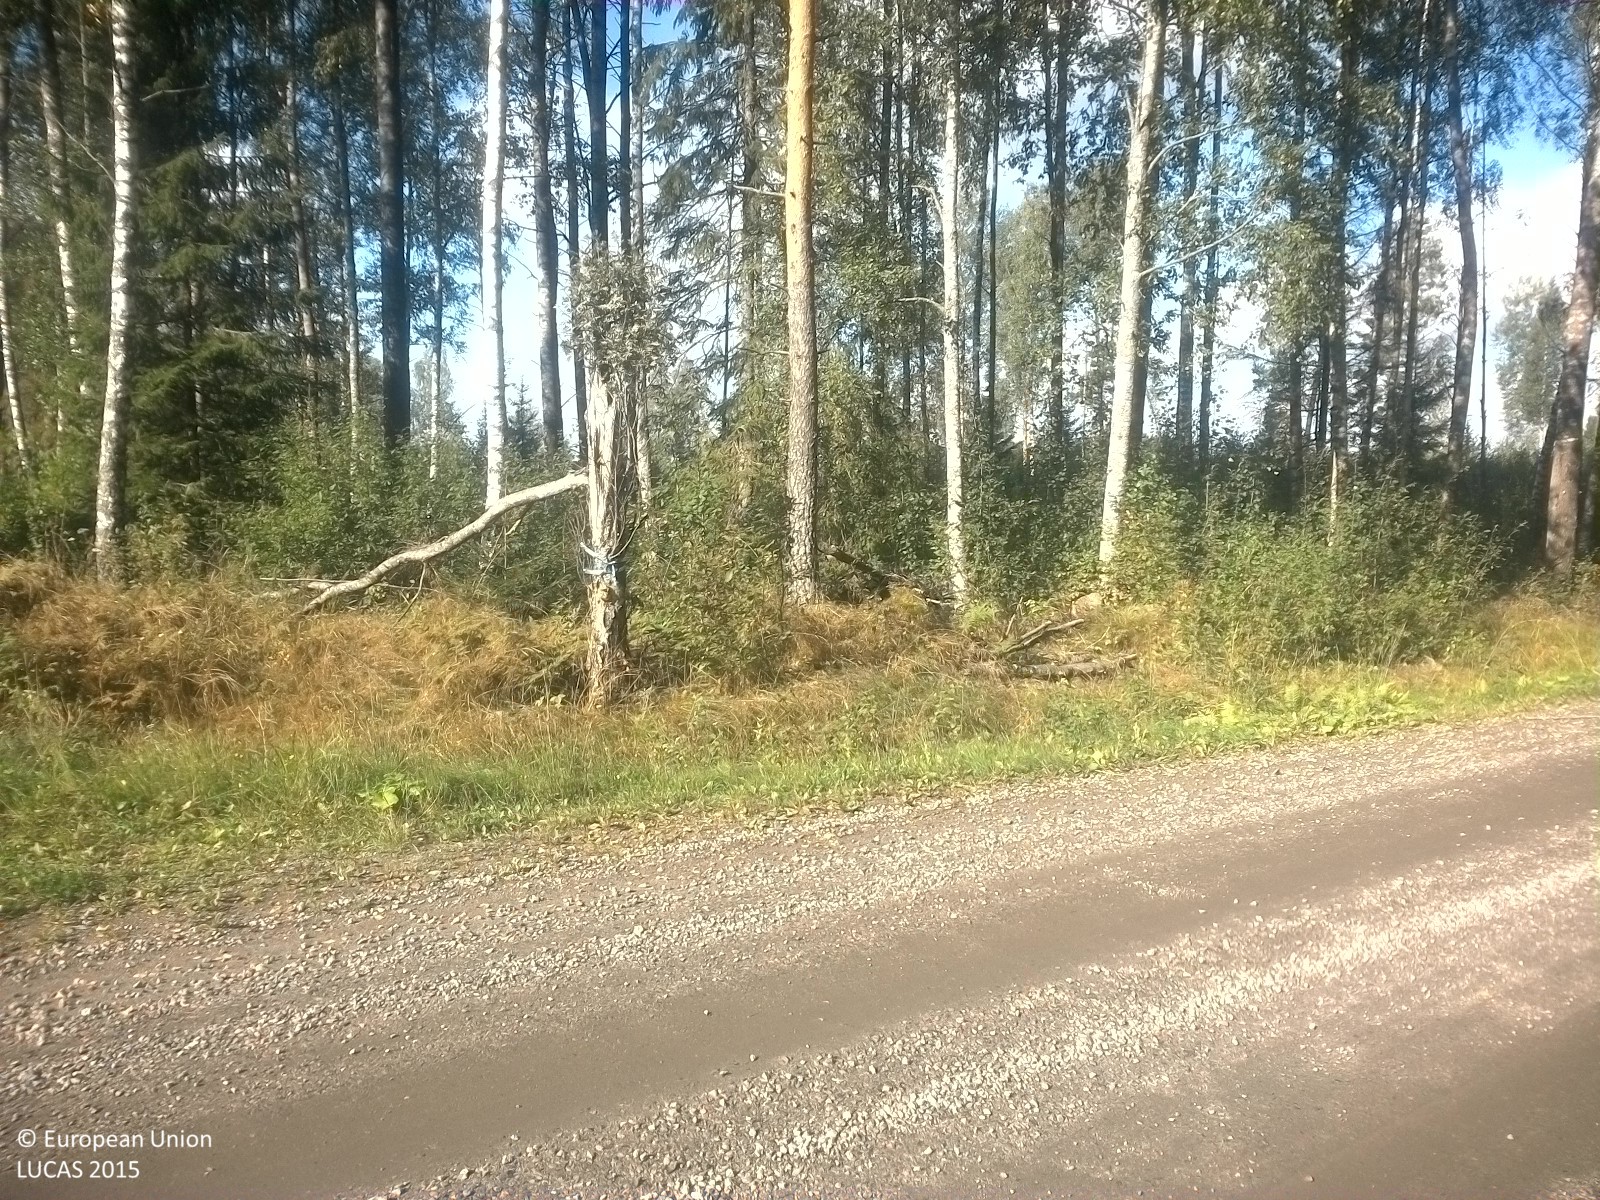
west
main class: Grassland
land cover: Spontaneously vegetated surfaces
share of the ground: > 75 %
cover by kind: herbaceous plants 100 %
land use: Semi-natural and natural areas not in use
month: September
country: SE
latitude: 59.3597
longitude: 15.7442
